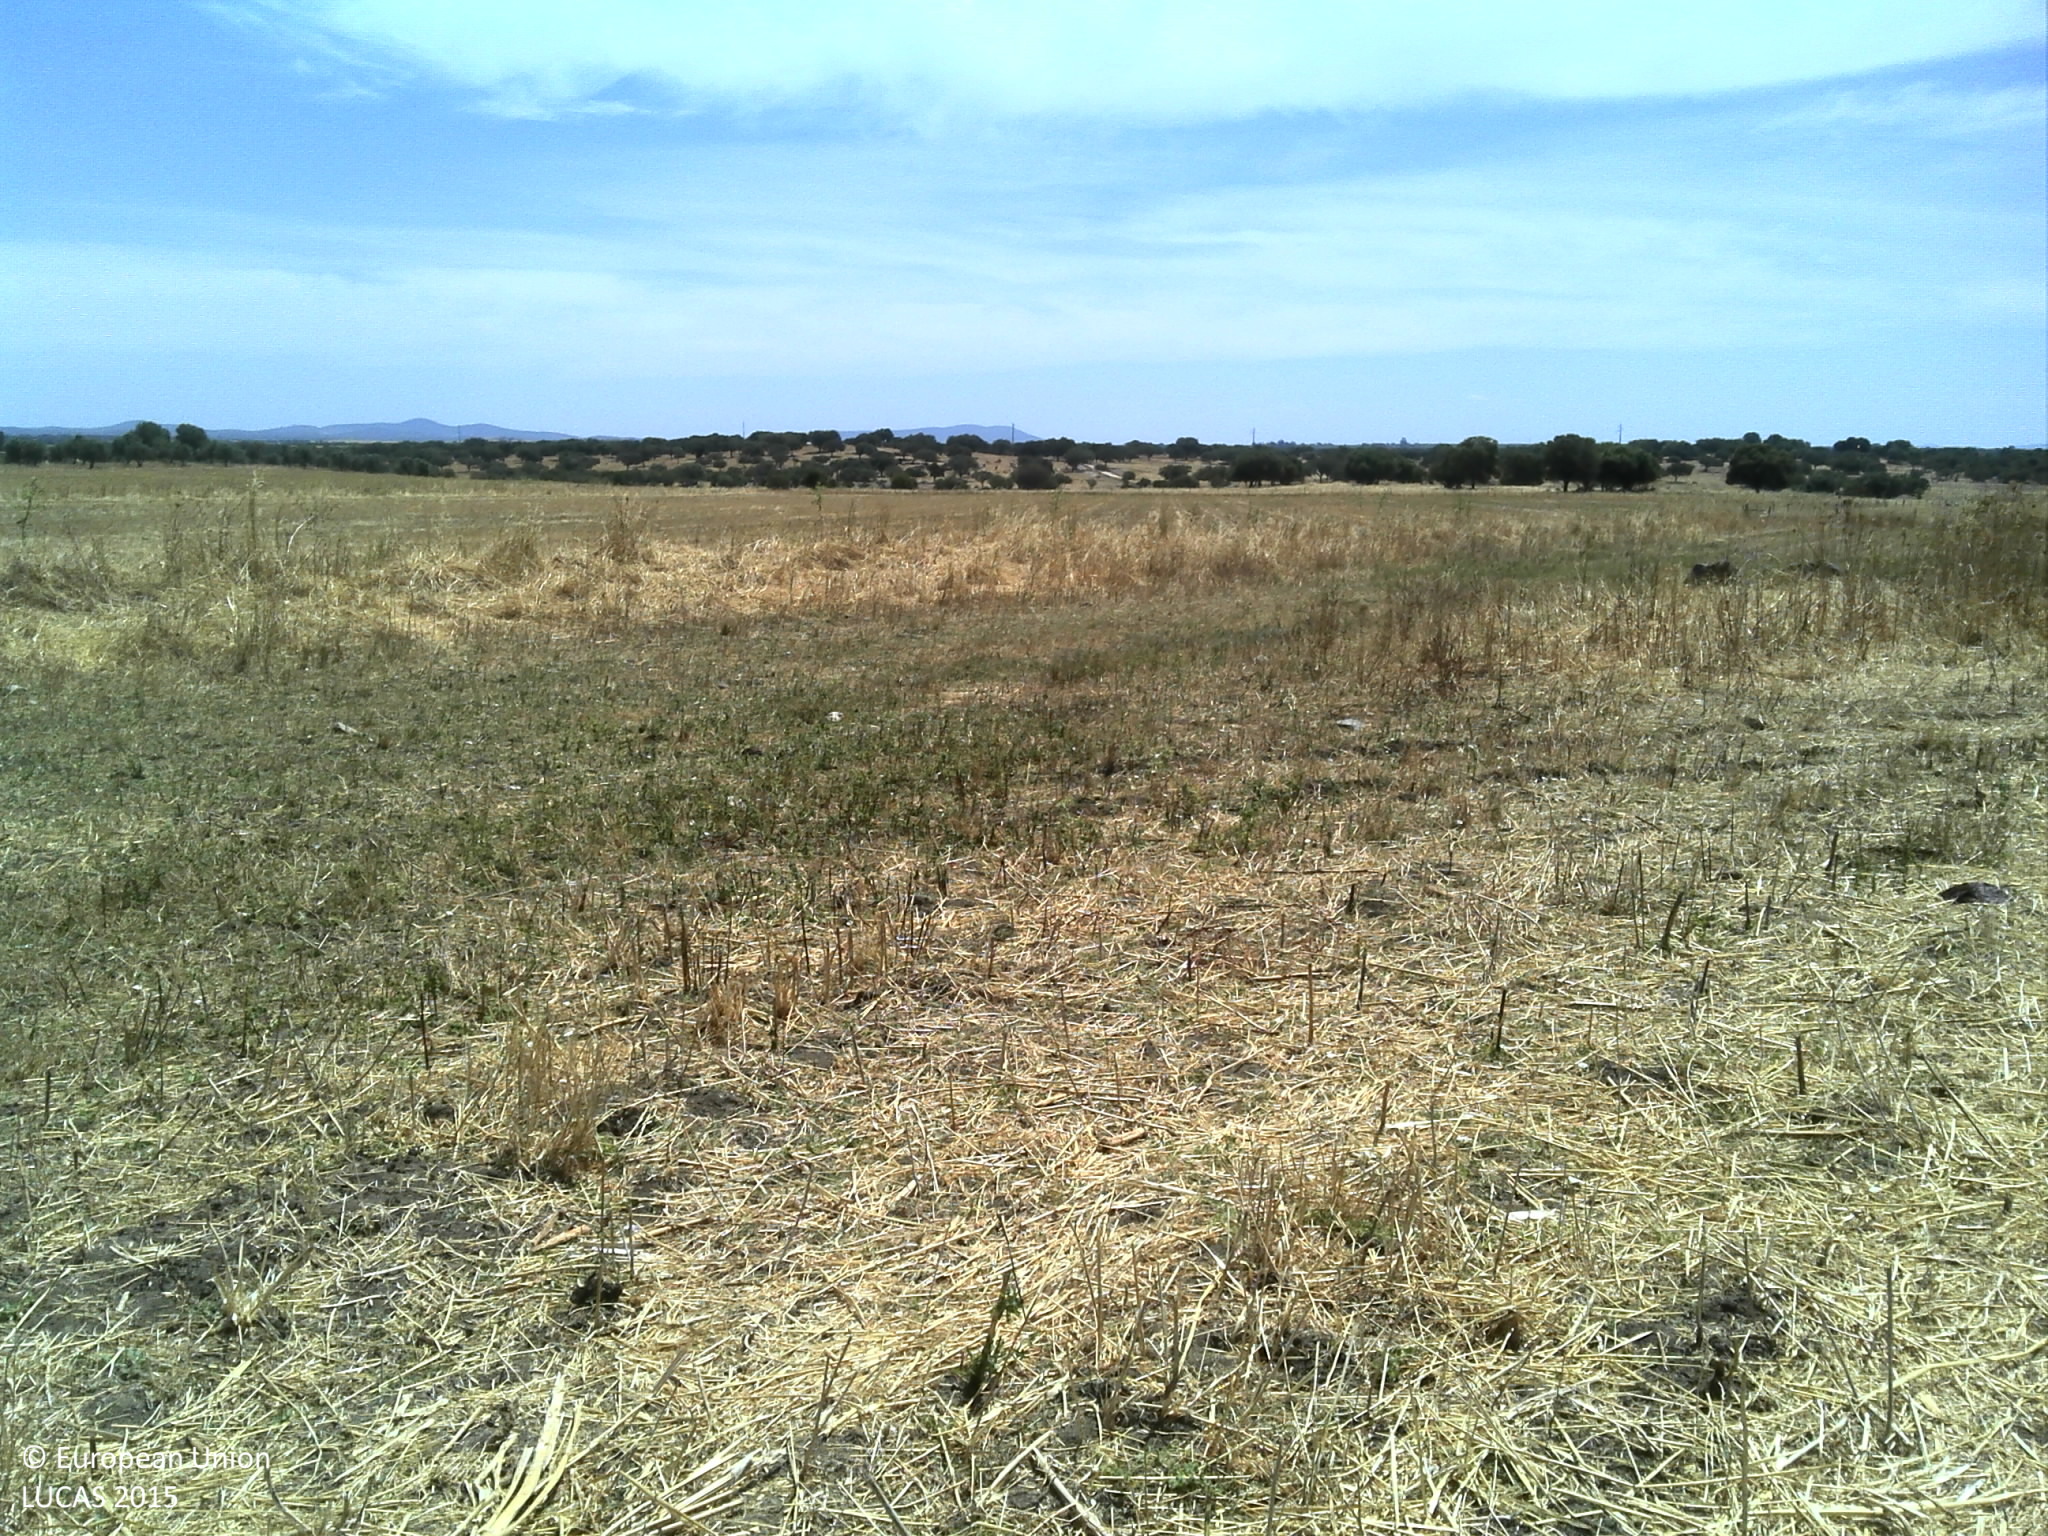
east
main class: Cropland
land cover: Common wheat
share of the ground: > 75 %
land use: Agriculture (excluding fallow land and kitchen gardens)
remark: Harvested field
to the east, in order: Common wheat; Grassland without tree/shrub cover; Ditches and canals; Grass margins; Tracks; Grassland without tree/shrub cover
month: June
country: PT
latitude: 37.9403
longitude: -7.5072
